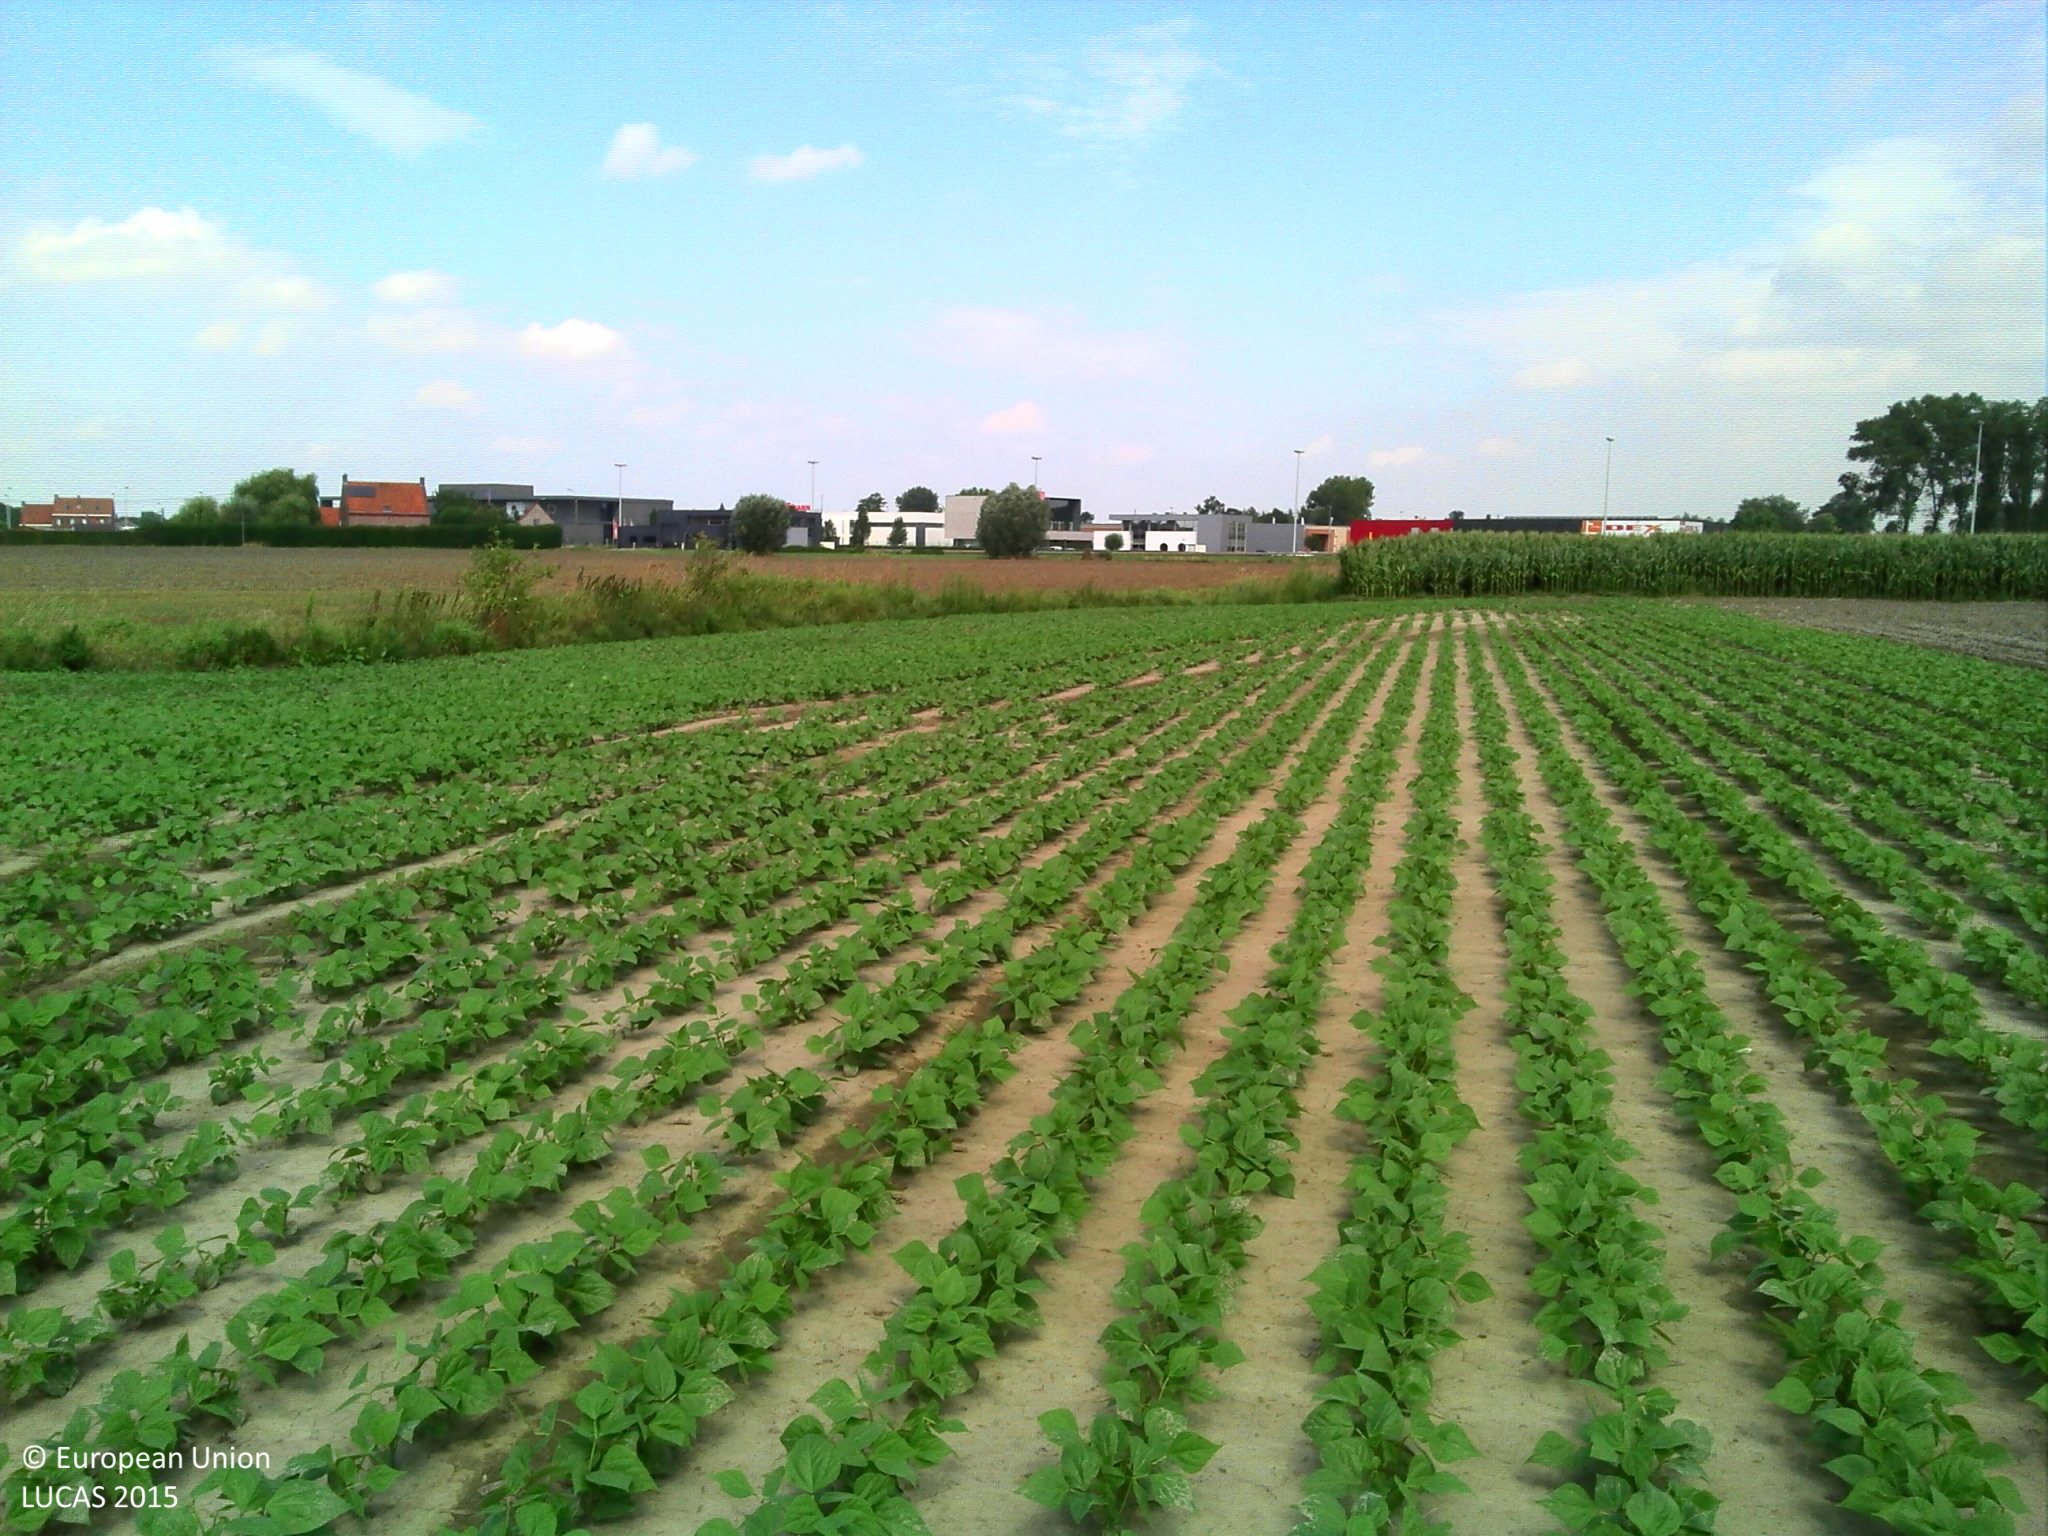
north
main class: Cropland
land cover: Other fresh vegetables
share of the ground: > 75 %
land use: Agriculture (excluding fallow land and kitchen gardens)
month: August
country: BE
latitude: 50.9718
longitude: 3.1692
